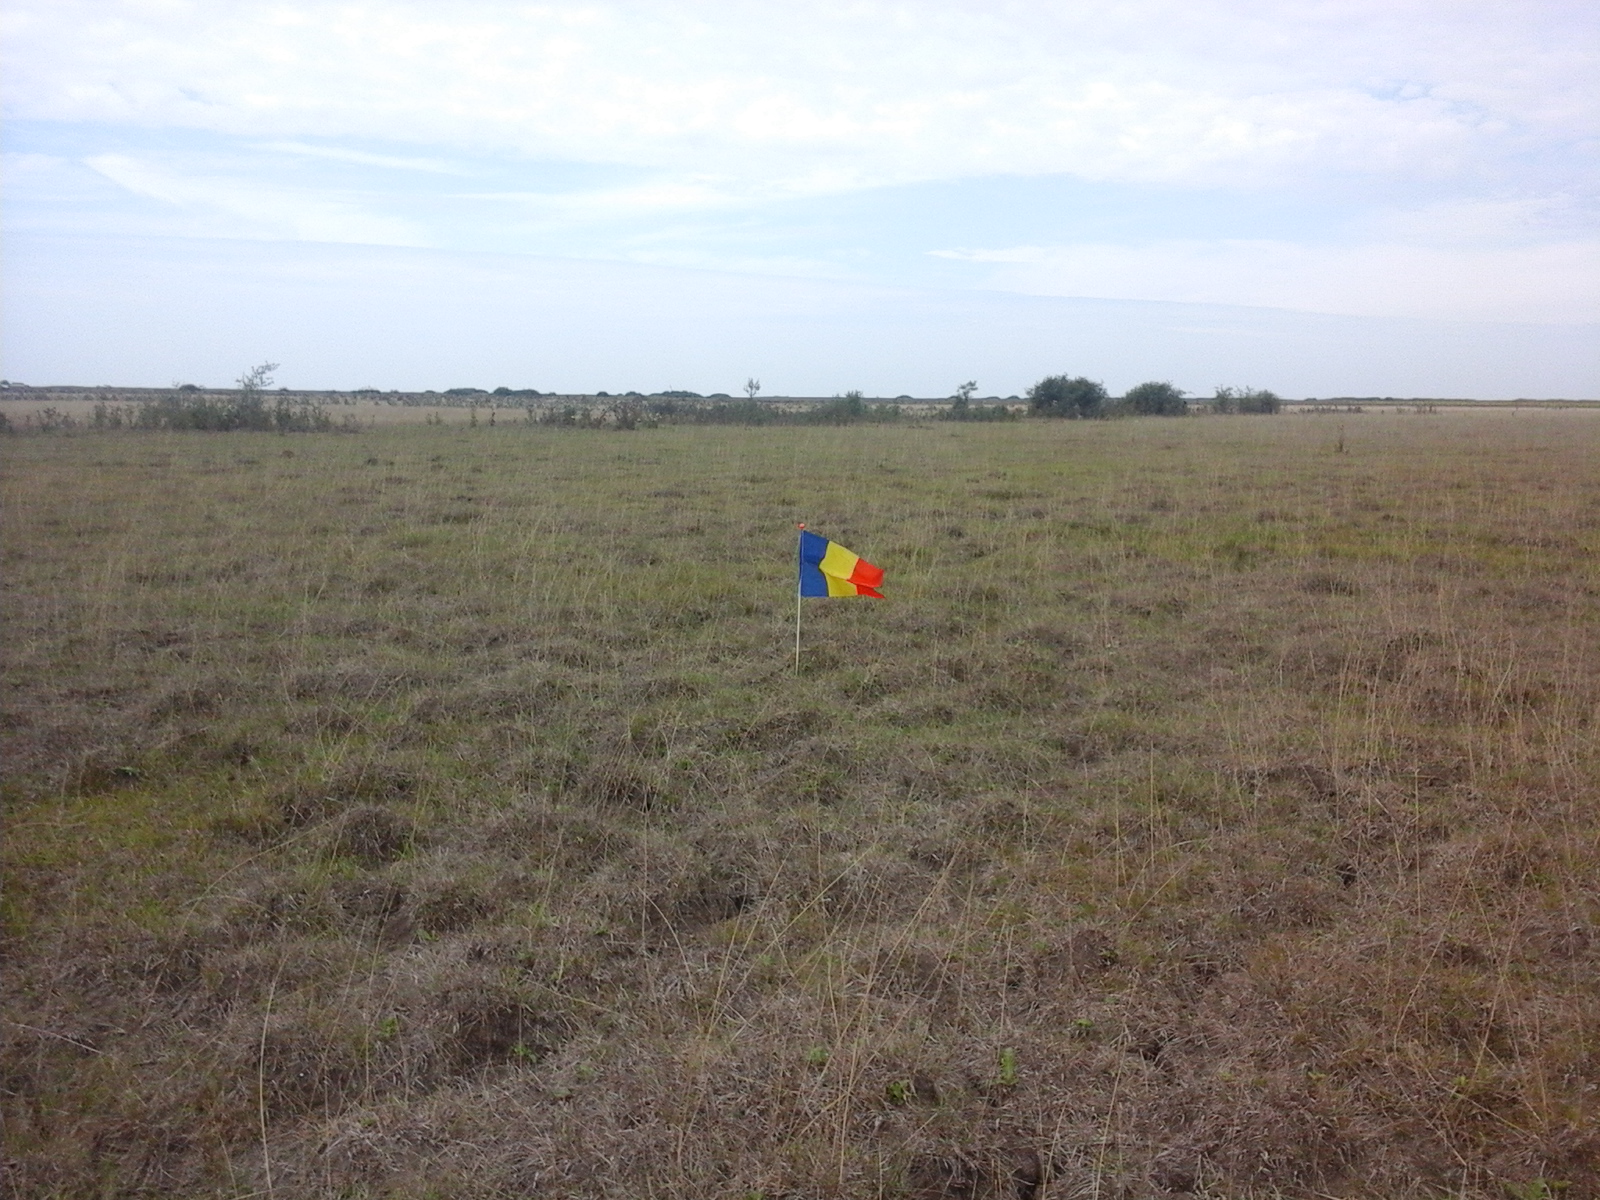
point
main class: Grassland
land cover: Grassland without tree/shrub cover
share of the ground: > 75 %
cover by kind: herbaceous plants 100 %
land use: Agriculture (excluding fallow land and kitchen gardens)
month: August
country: RO
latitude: 46.5374
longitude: 21.4202
